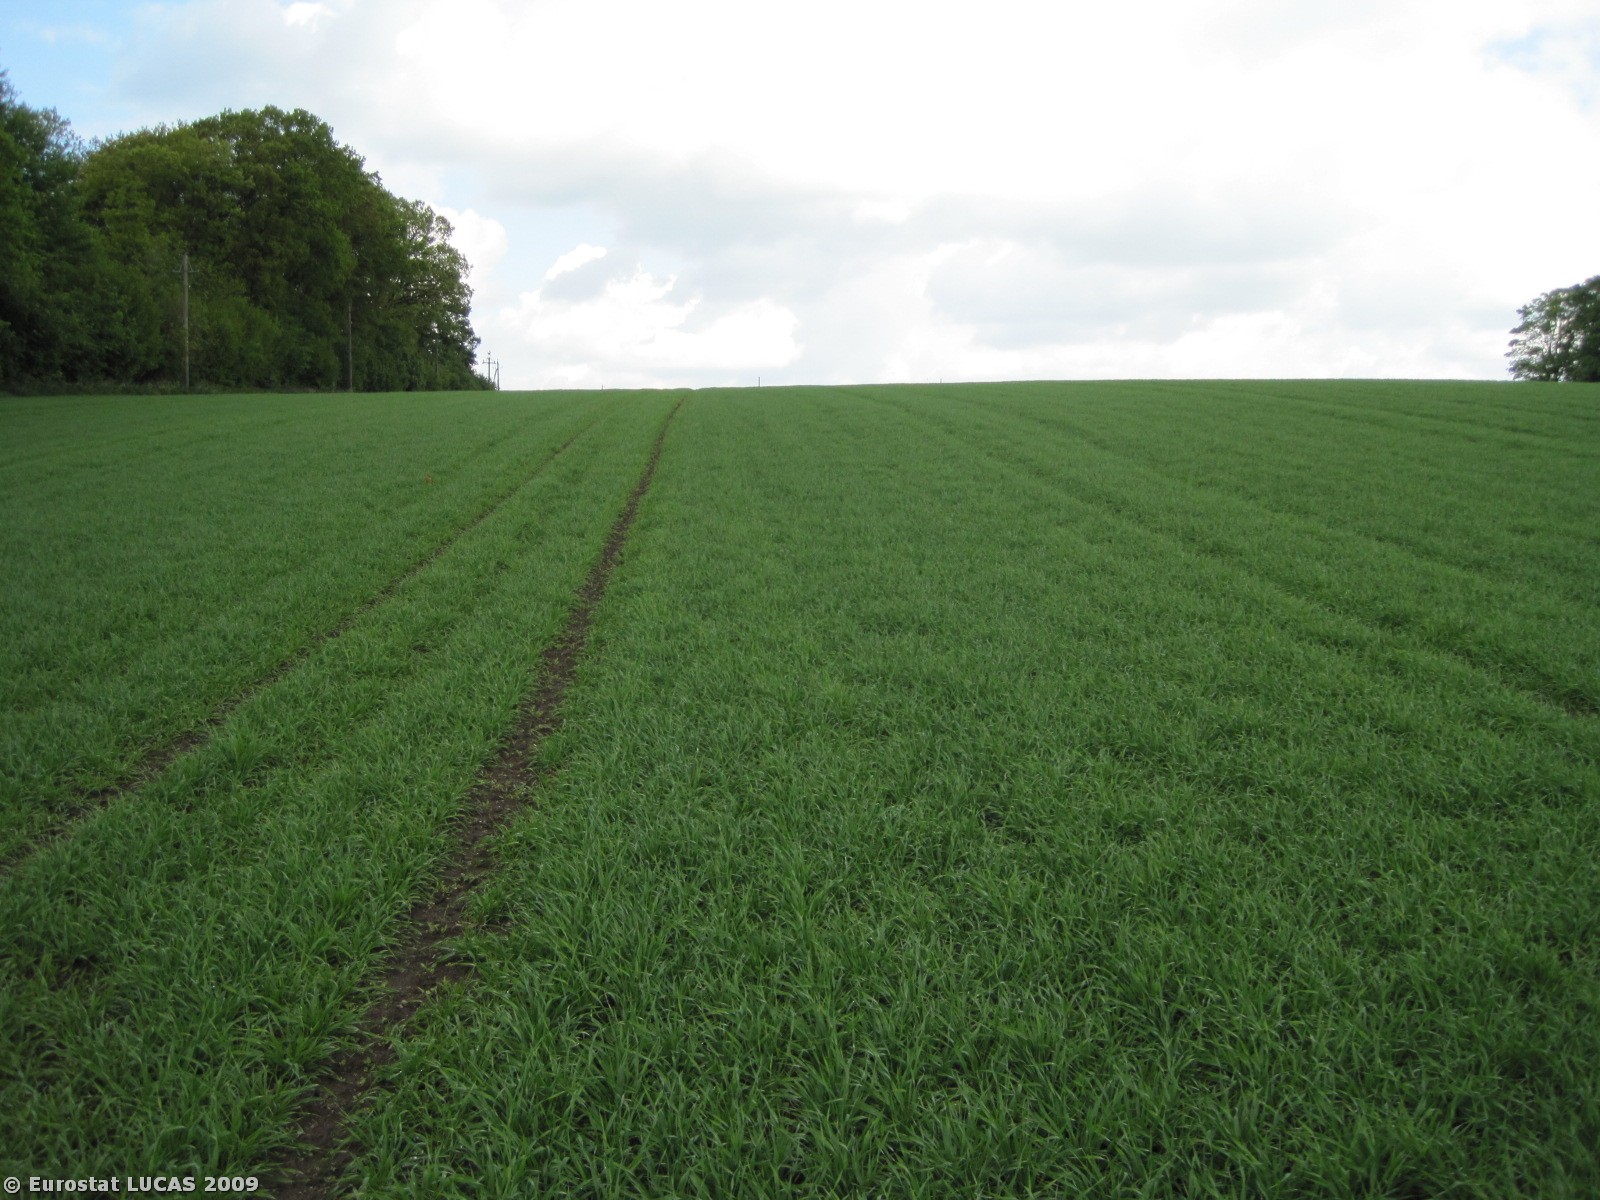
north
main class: Cropland
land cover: Barley
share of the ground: > 75 %
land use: Agriculture (excluding fallow land and kitchen gardens)
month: May
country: DK
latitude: 56.3493
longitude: 9.7576
